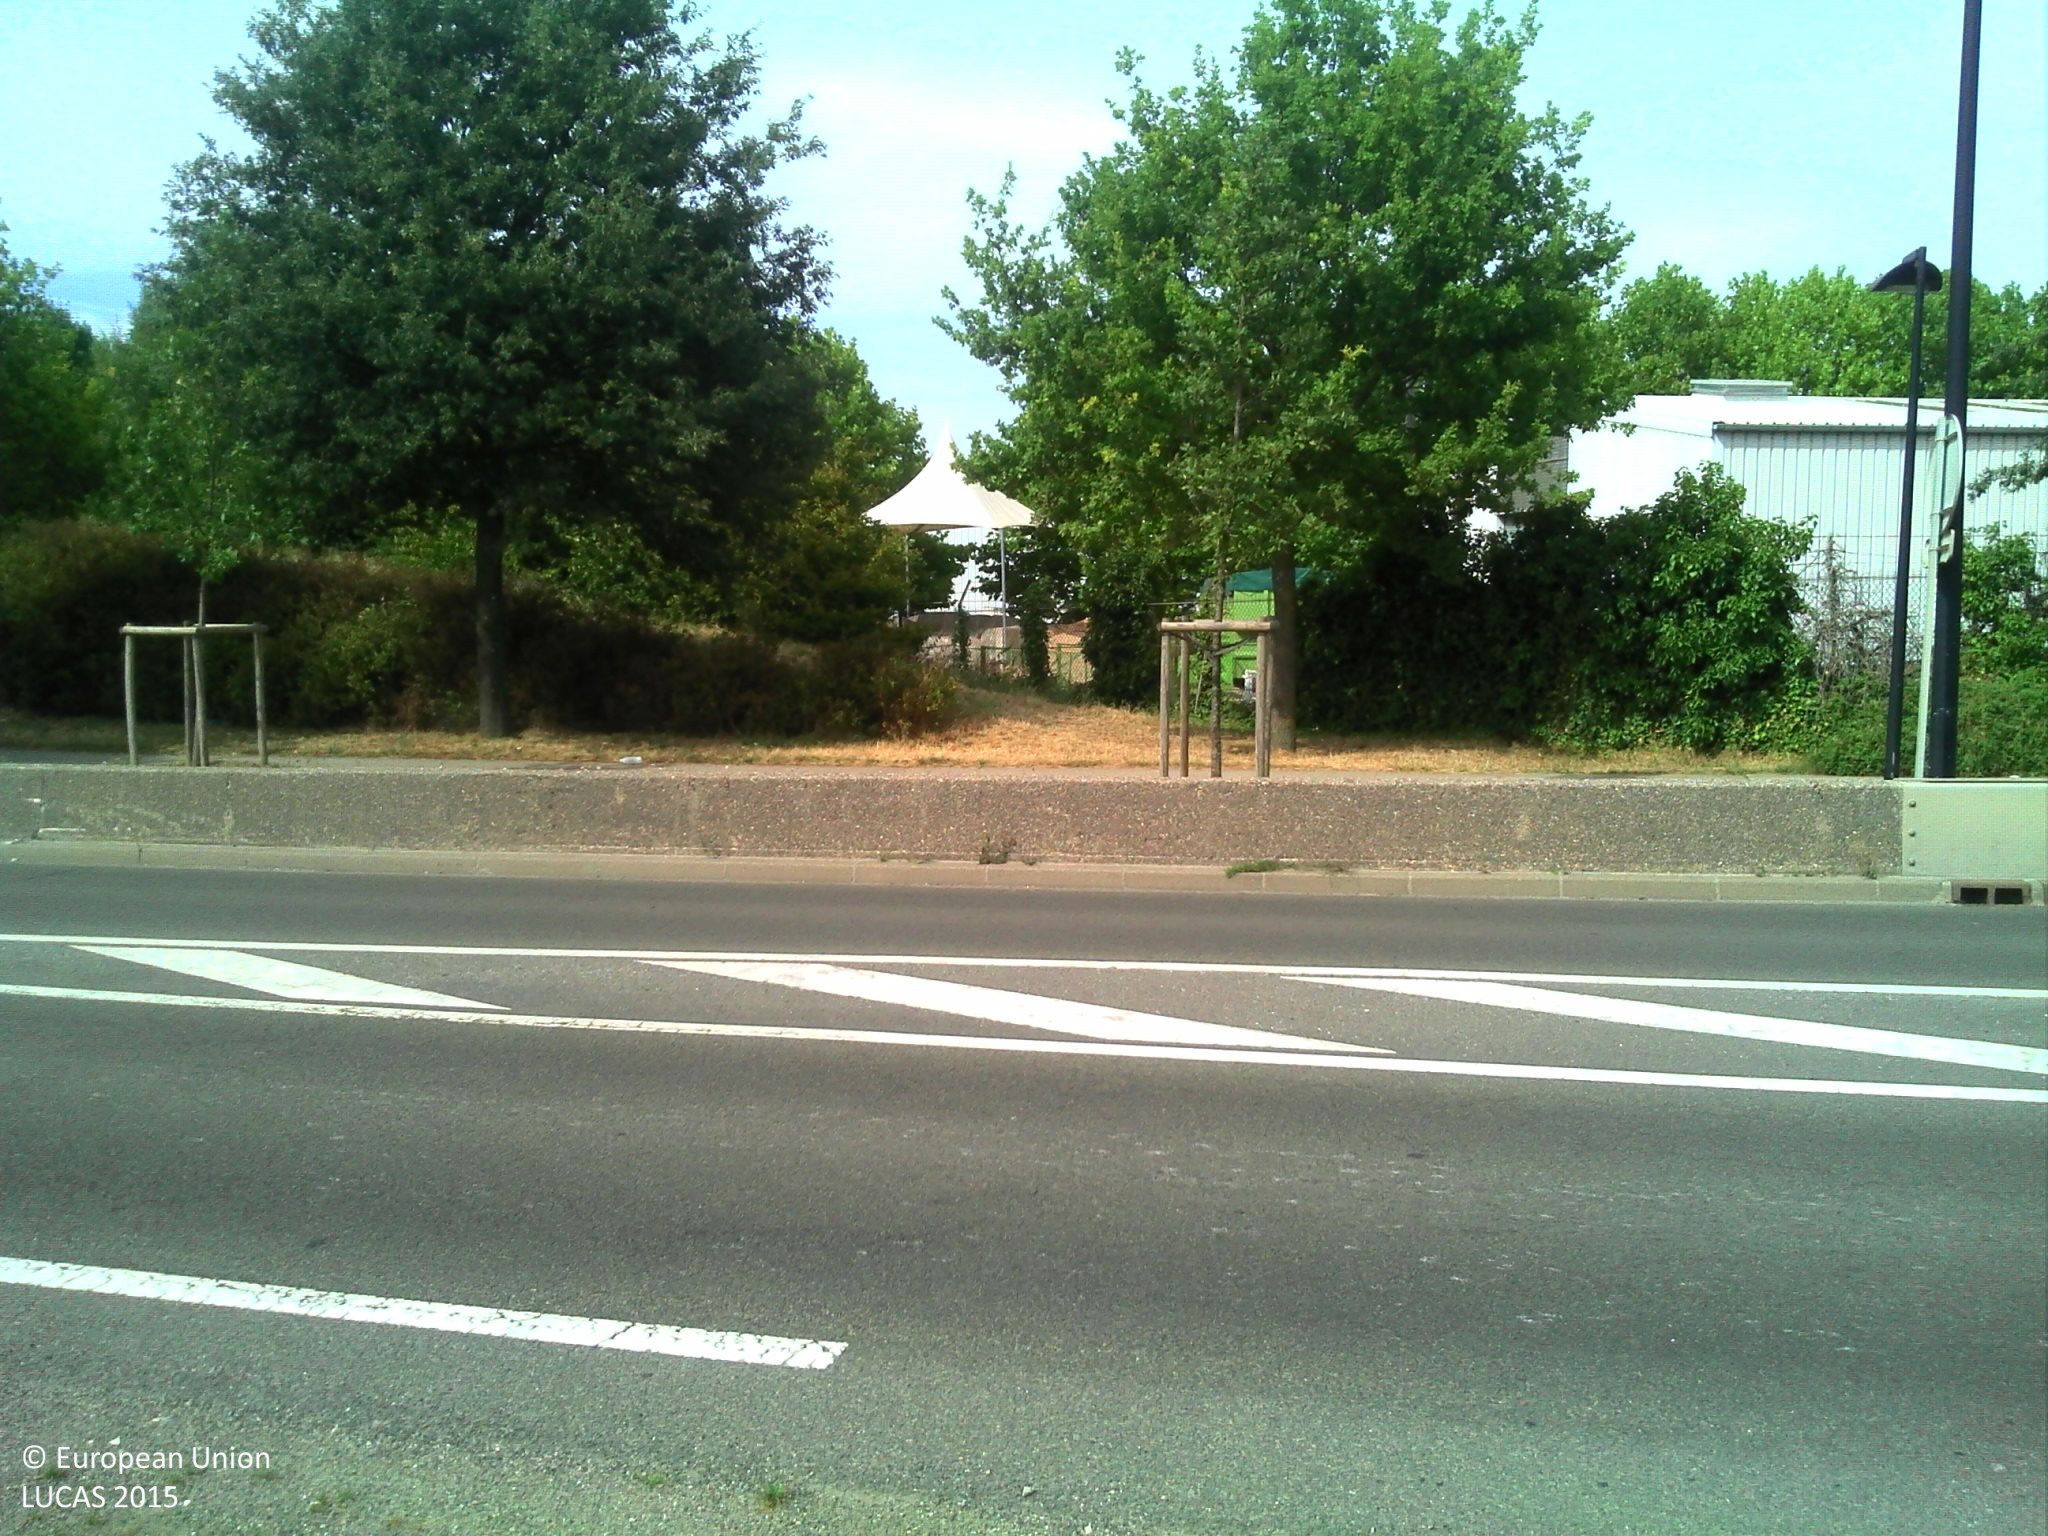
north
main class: Grassland
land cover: Grassland without tree/shrub cover
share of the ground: > 75 %
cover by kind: herbaceous plants 100 %
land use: Air transport
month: August
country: FR
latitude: 48.7372
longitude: 2.3874
